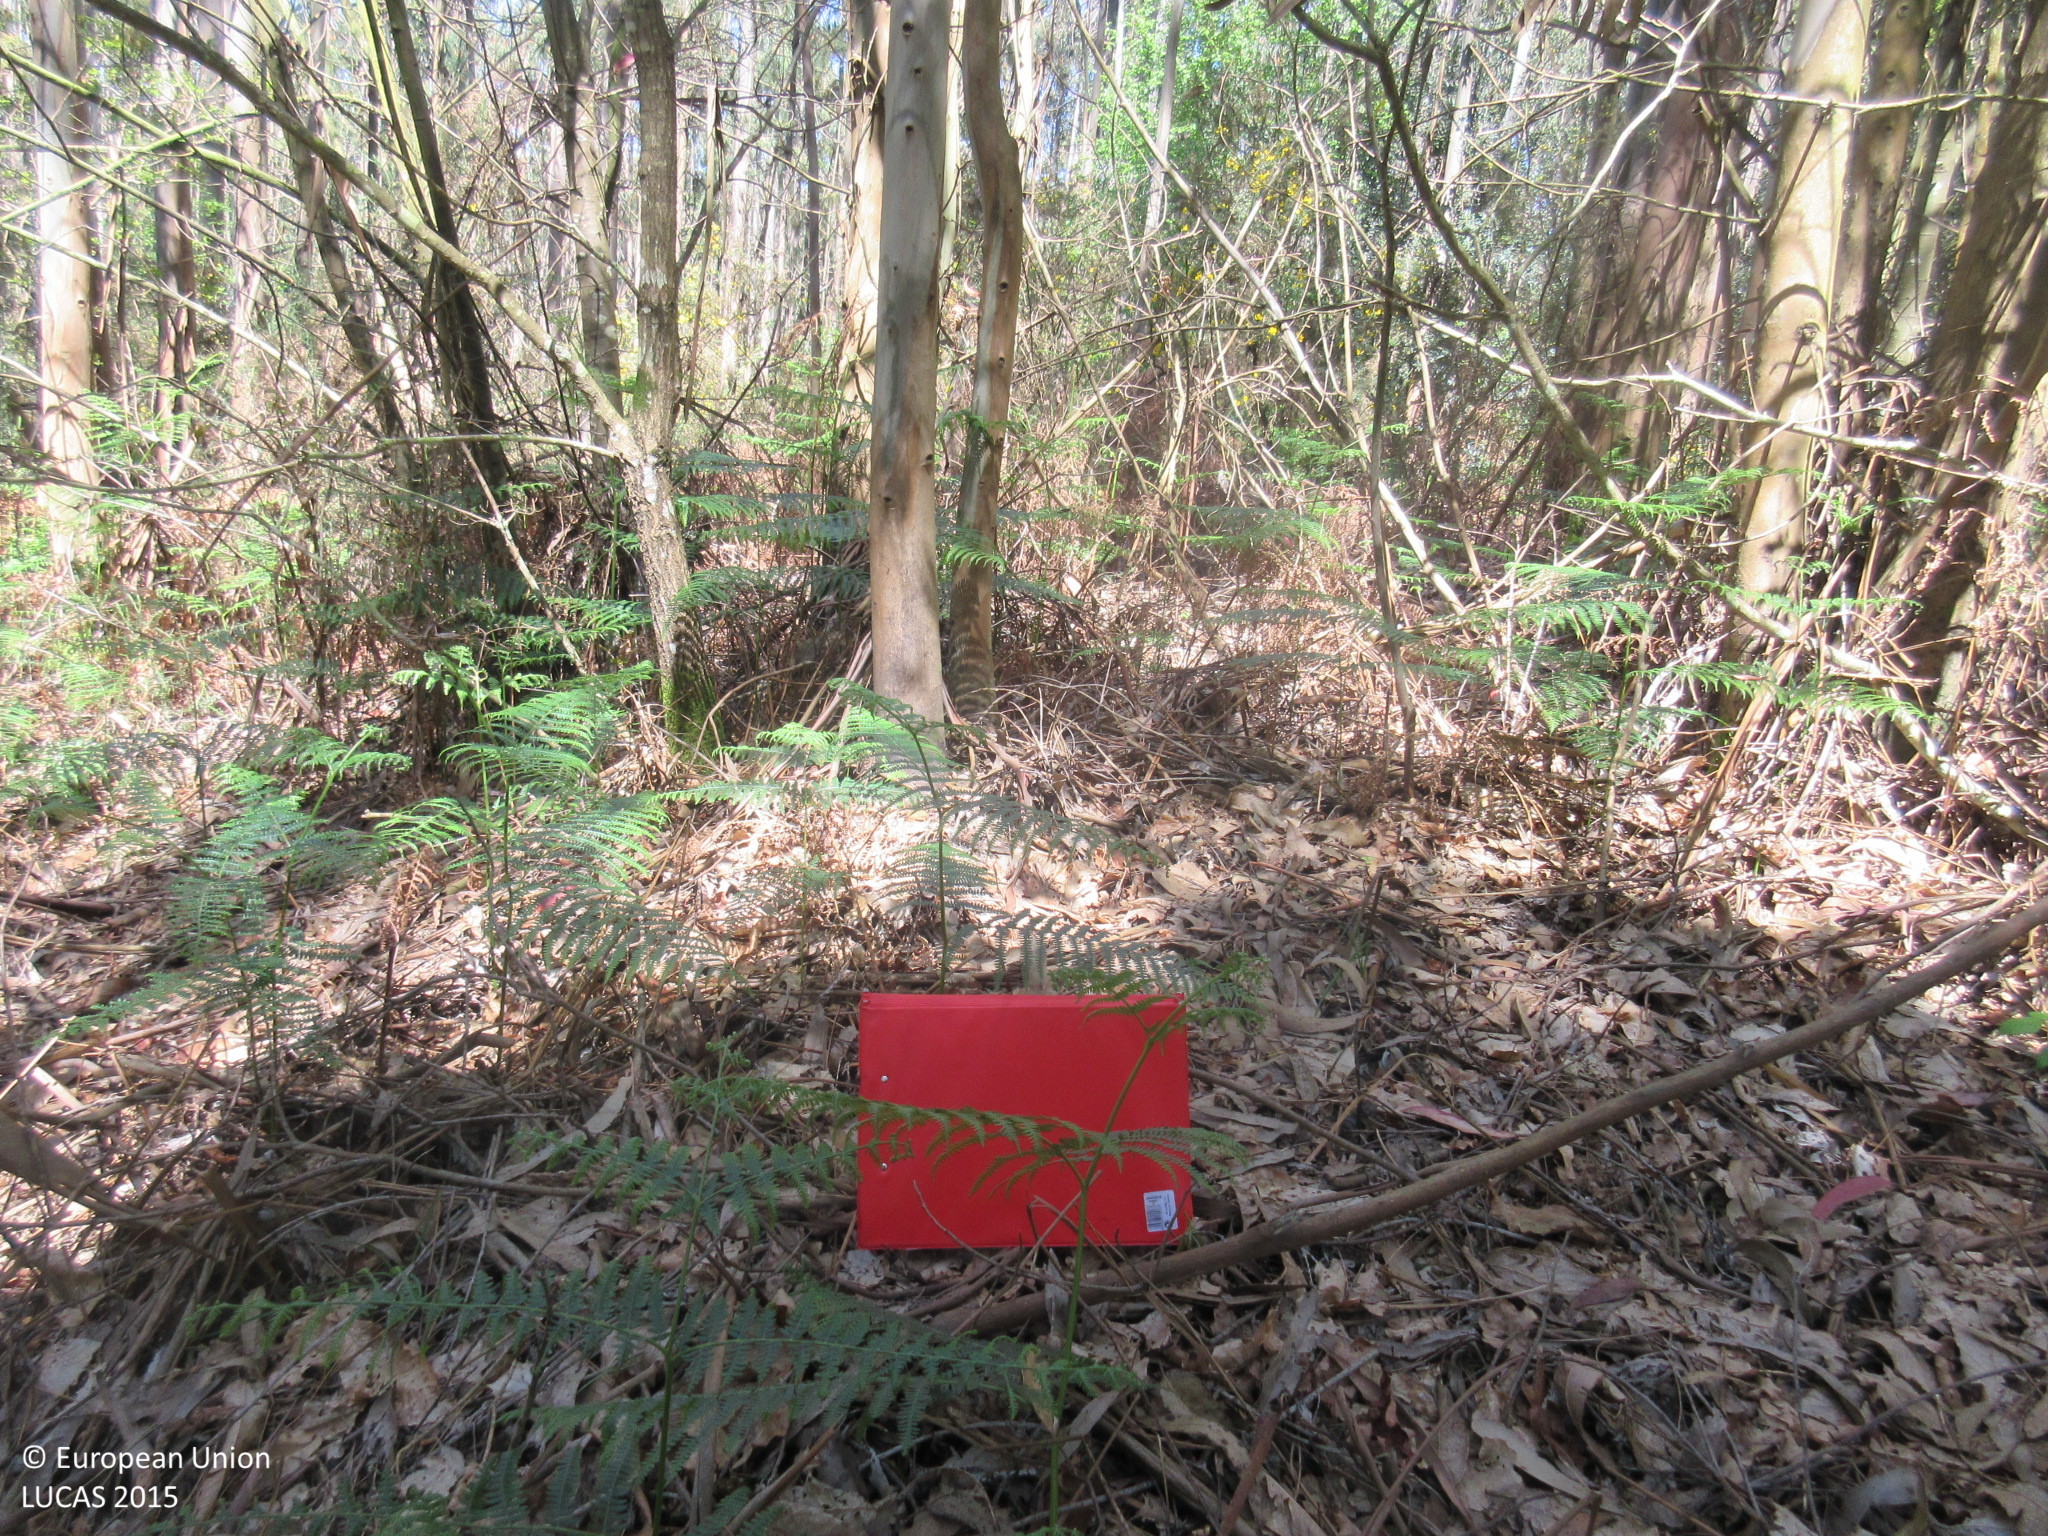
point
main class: Woodland
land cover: Broadleaved woodland
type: exotic forest
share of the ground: > 75 %
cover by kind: broadleaved forest trees 95 %, shrubs 5 %
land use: Forestry
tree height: > 5 m
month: April
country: ES
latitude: 43.4840
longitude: -7.0196
